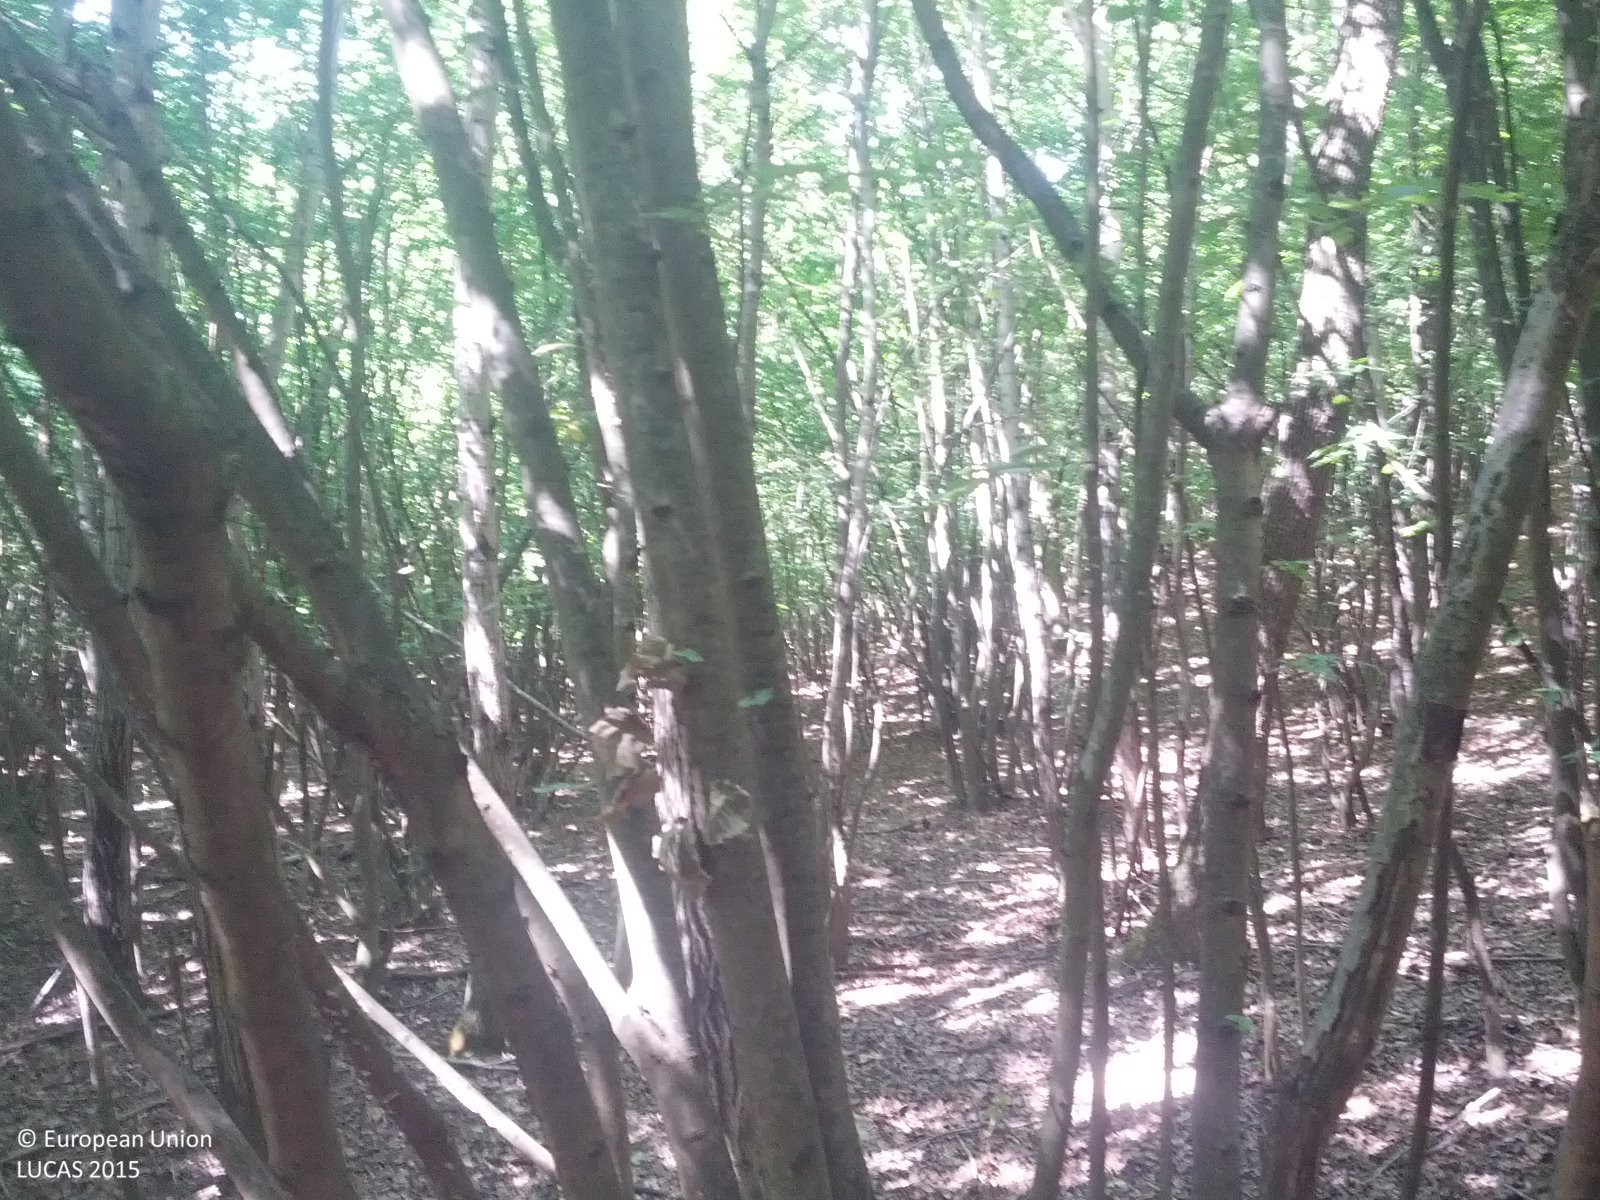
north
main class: Woodland
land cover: Broadleaved woodland
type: beech forest
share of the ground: > 75 %
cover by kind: broadleaved forest trees 90 %, herbaceous plants 5 %, unconsolidated bare surface 5 %
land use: Forestry
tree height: > 5 m
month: July
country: AT
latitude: 48.5554
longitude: 16.4958
